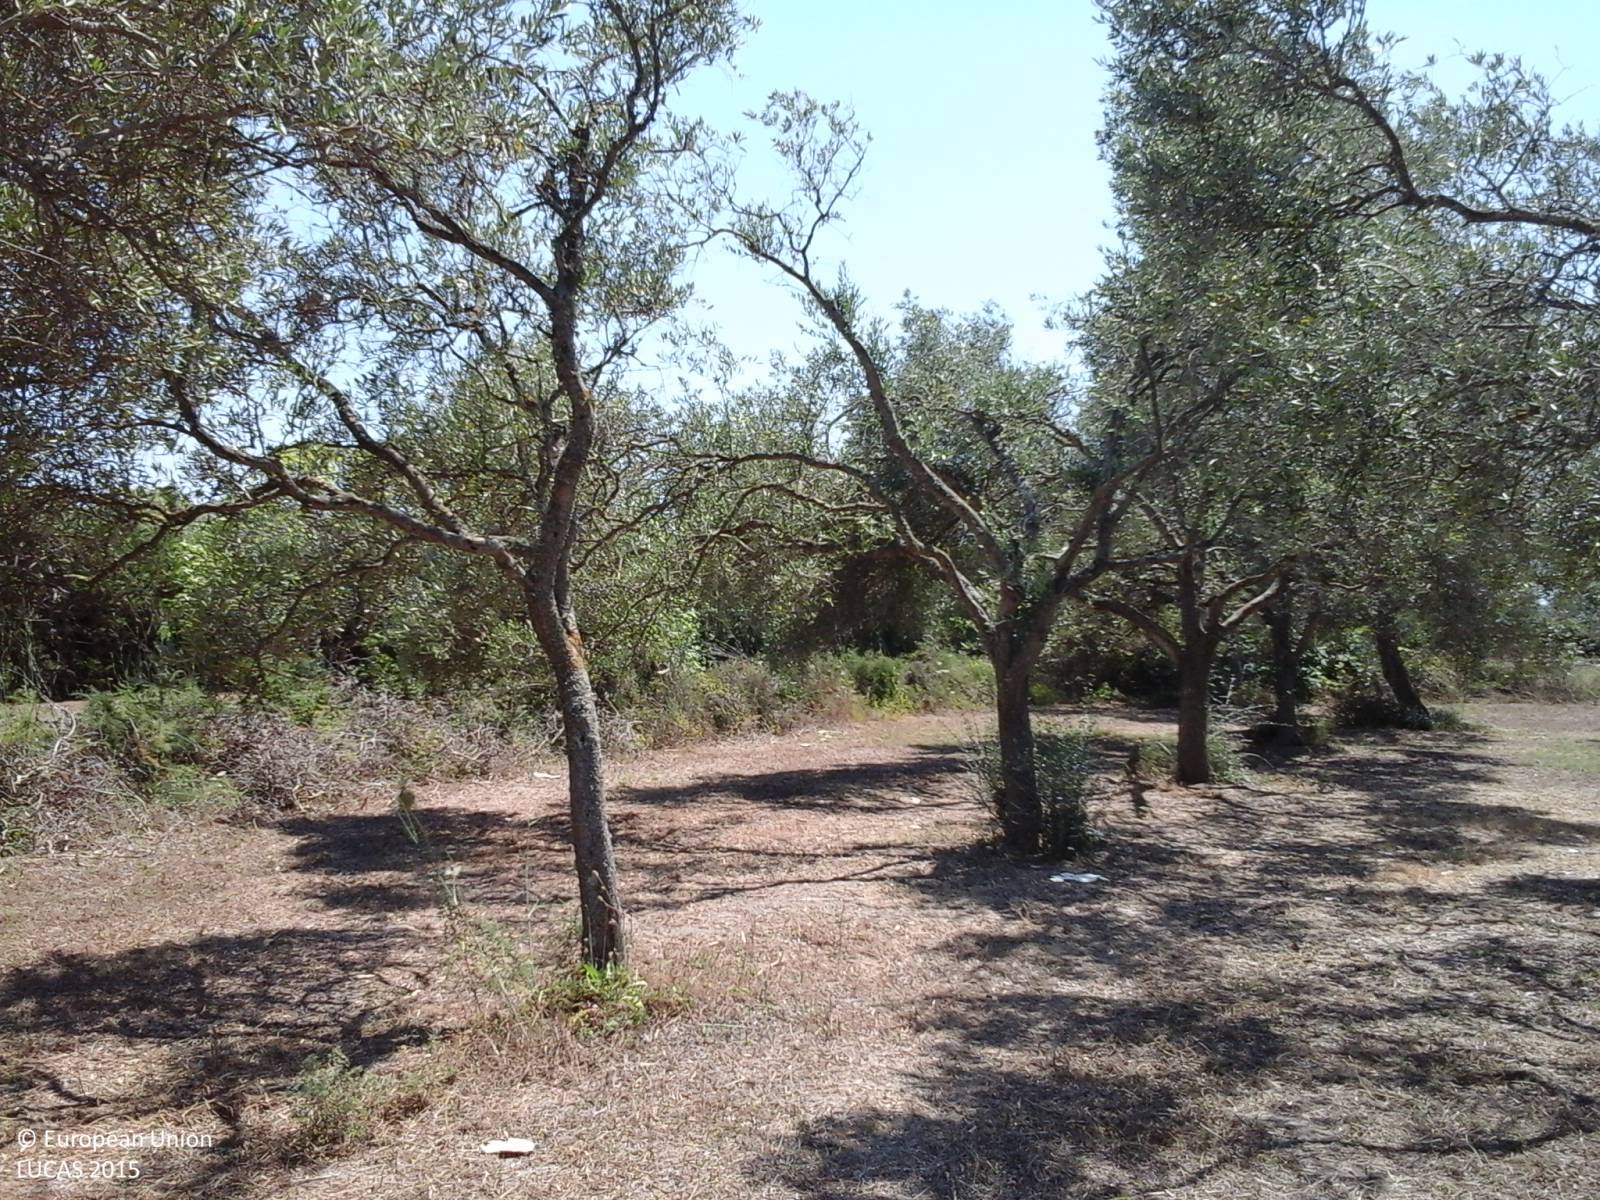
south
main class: Cropland
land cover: Olive groves
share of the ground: > 75 %
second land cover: Grassland without tree/shrub cover
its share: > 75 %
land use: Agriculture (excluding fallow land and kitchen gardens)
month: July
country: IT
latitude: 39.9665
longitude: 8.5212
